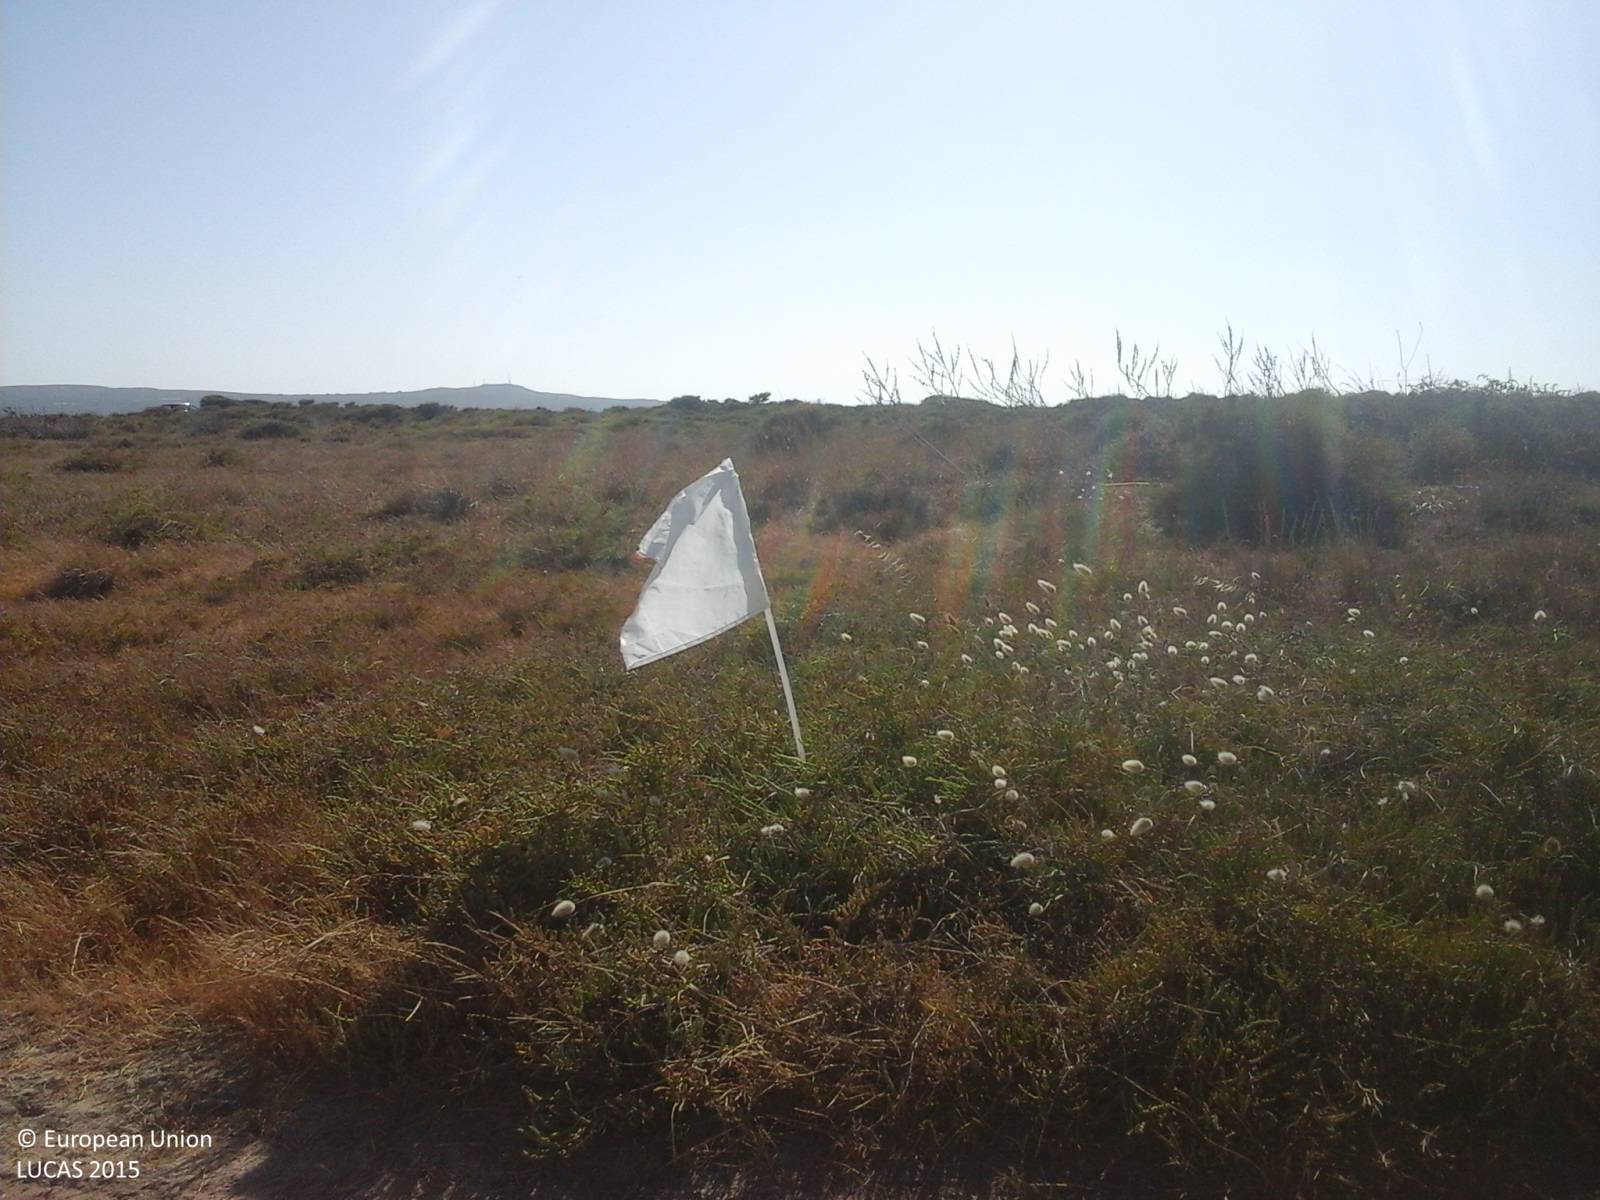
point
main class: Grassland
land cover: Grassland without tree/shrub cover
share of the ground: > 75 %
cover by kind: herbaceous plants 90 %, unconsolidated bare surface 10 %
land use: Semi-natural and natural areas not in use
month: July
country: IT
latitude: 39.1141
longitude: 8.4714
